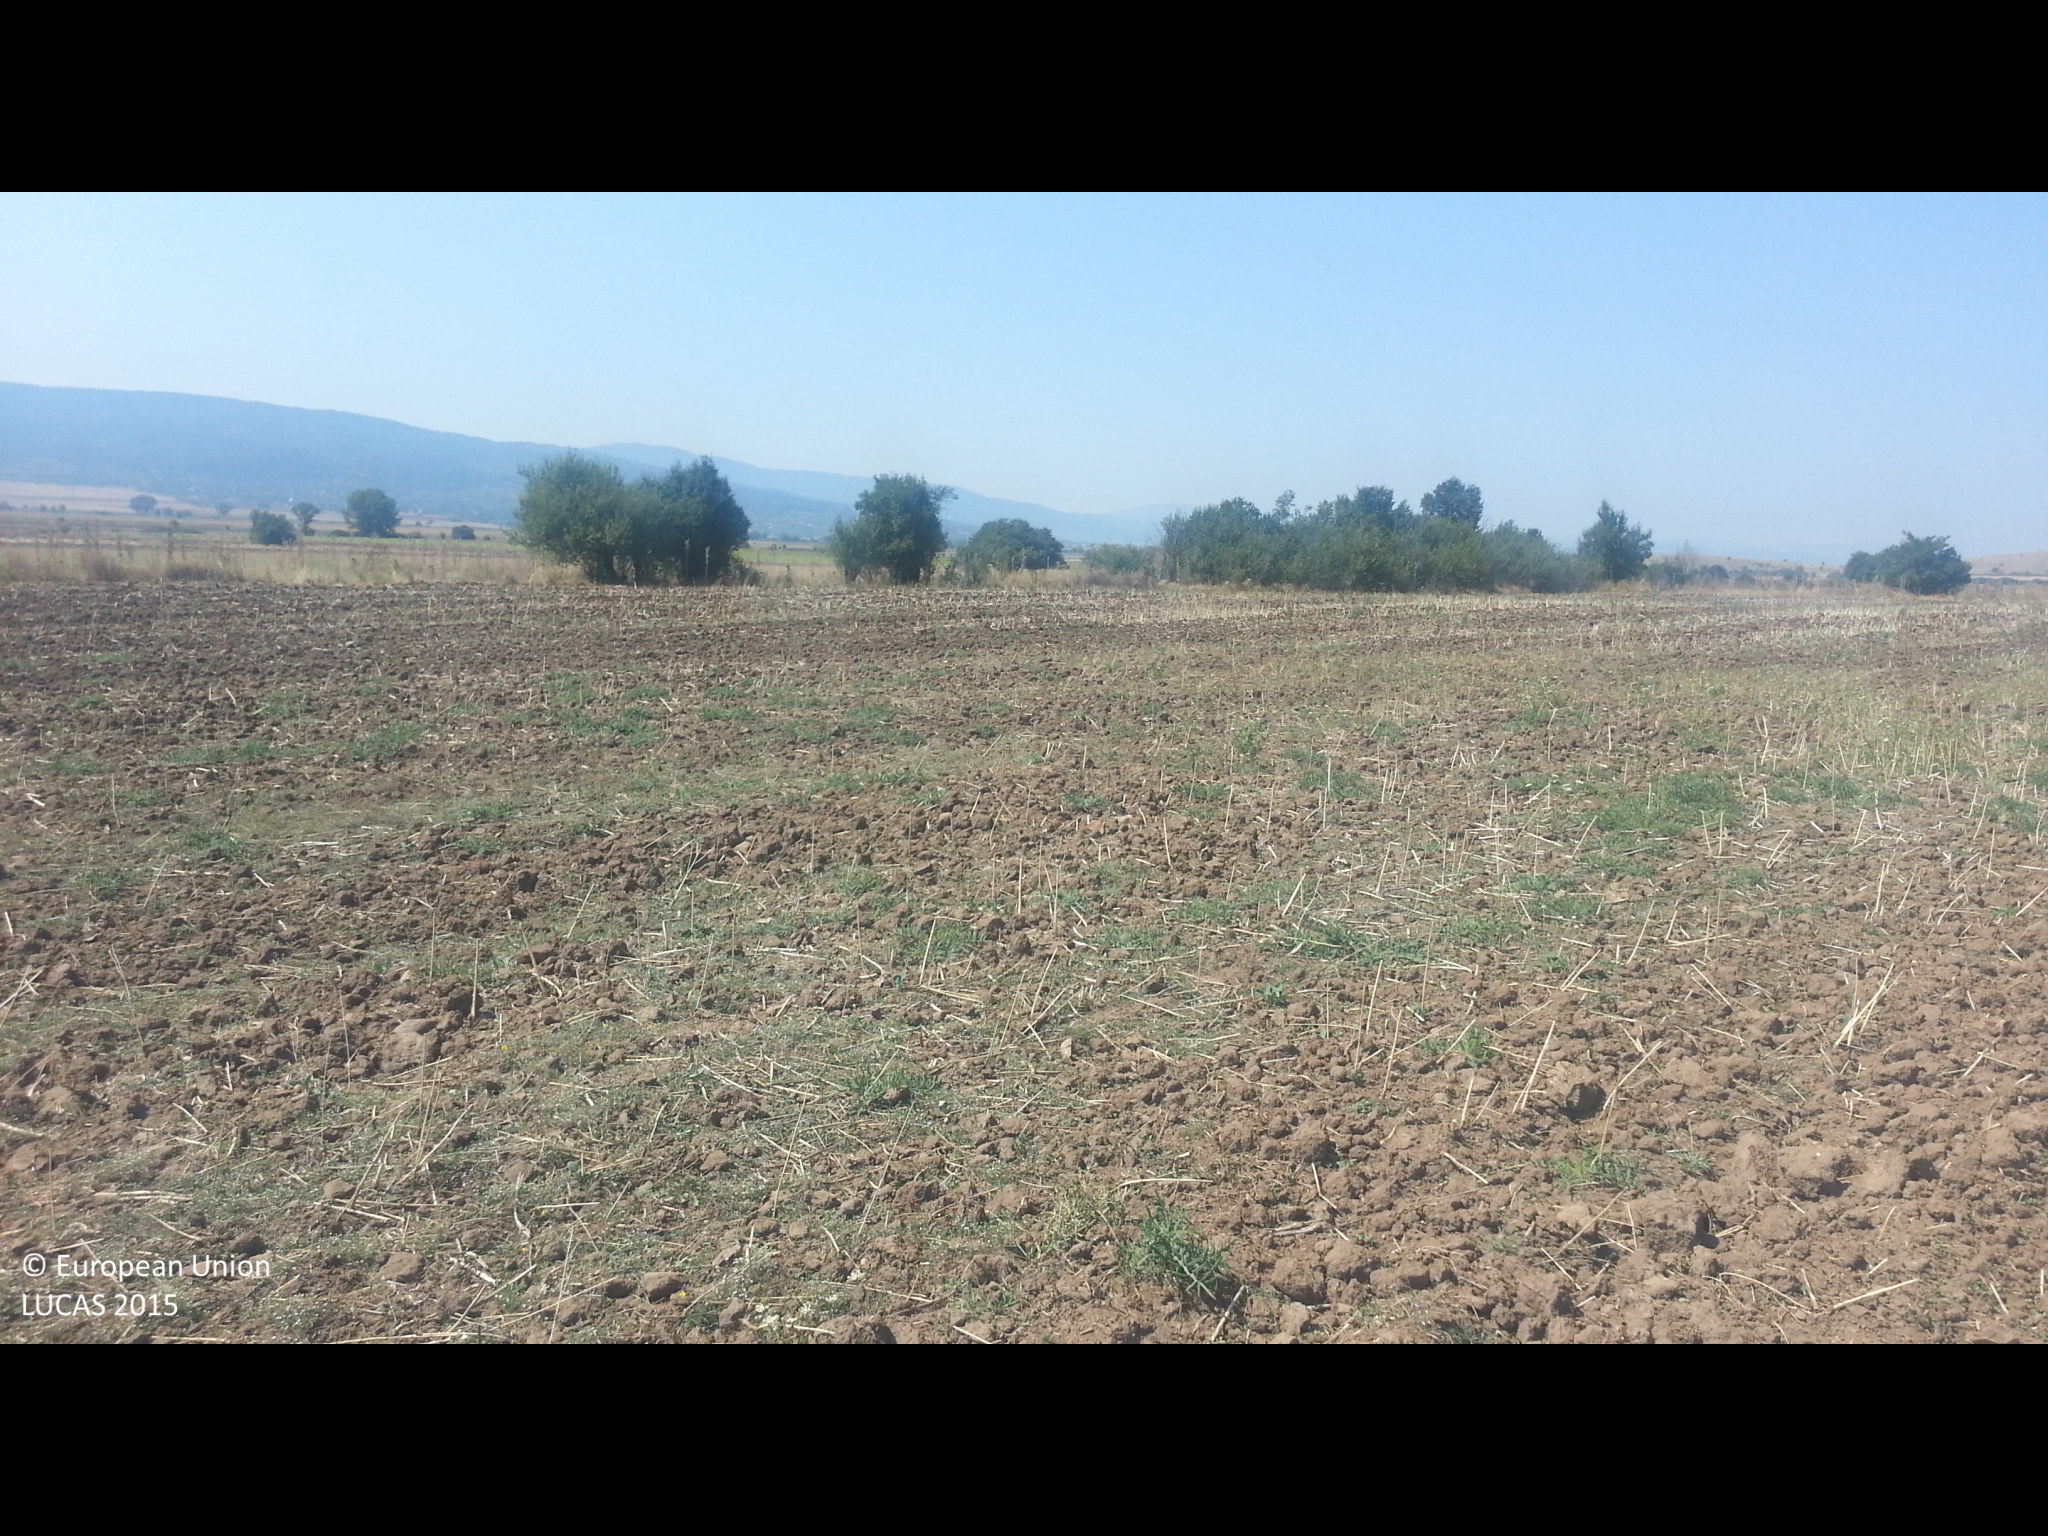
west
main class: Grassland
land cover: Spontaneously vegetated surfaces
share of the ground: 25 - 50 %
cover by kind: consolidated bare surface 65 %, herbaceous plants 35 %
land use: Agriculture (excluding fallow land and kitchen gardens)
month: August
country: BG
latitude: 42.4421
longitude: 23.0731
